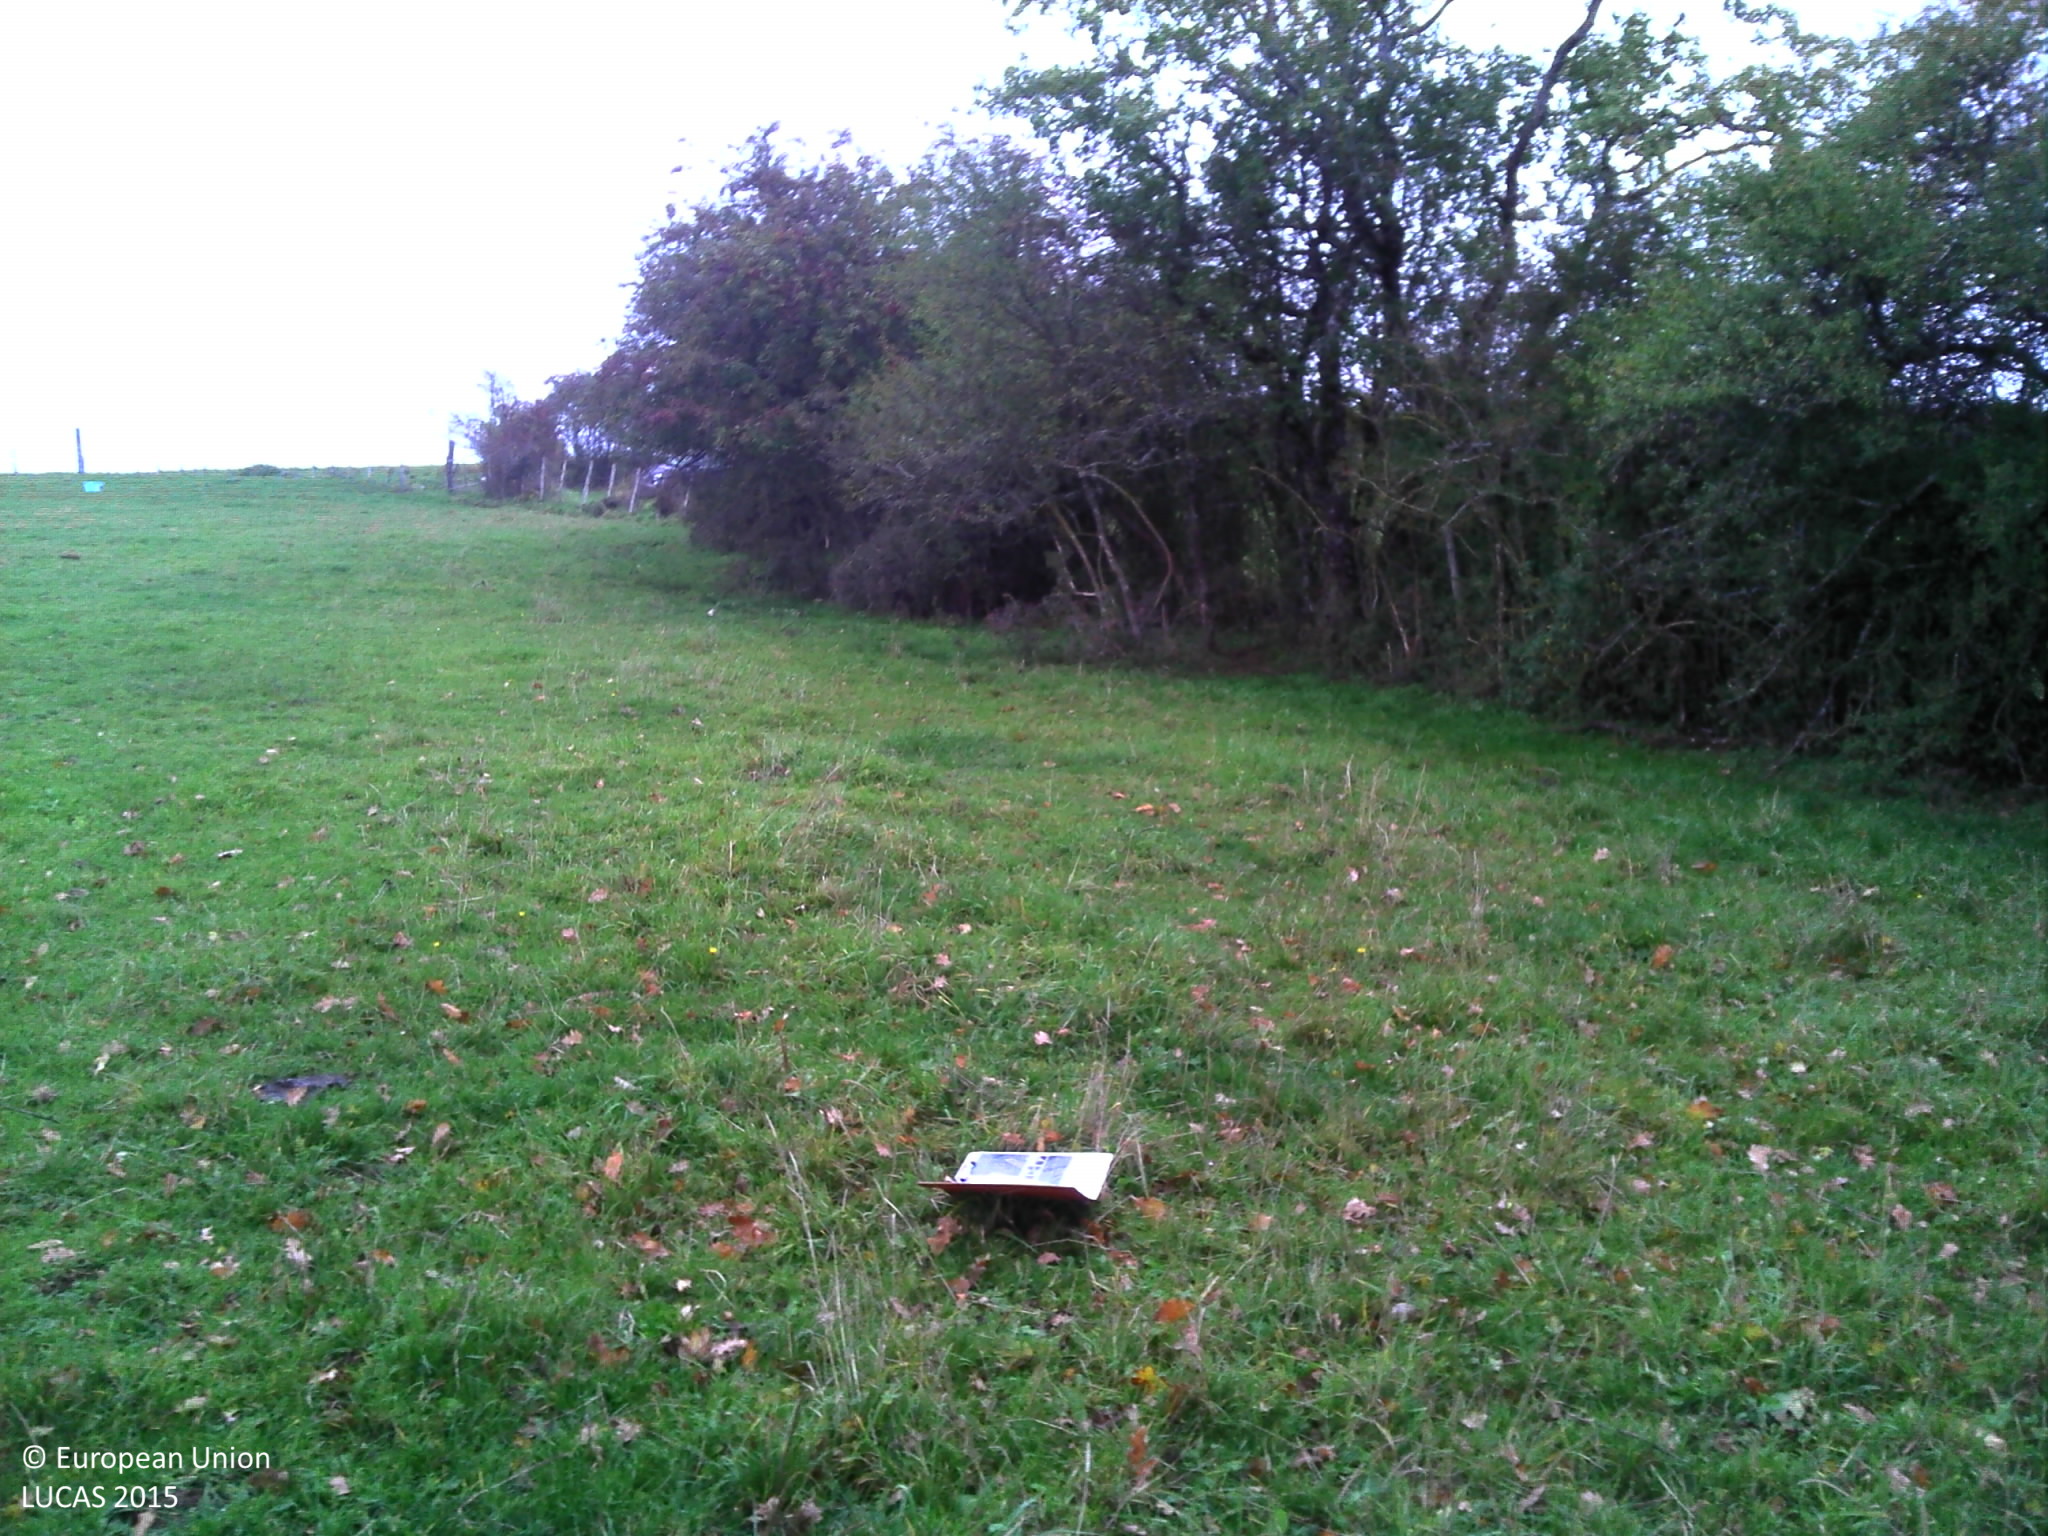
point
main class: Grassland
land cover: Grassland with sparse tree/shrub cover
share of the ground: > 75 %
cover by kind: herbaceous plants 95 %, broadleaved forest trees 5 %
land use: Agriculture (excluding fallow land and kitchen gardens)
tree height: > 5 m
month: October
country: FR
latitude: 46.9887
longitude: 6.2550
